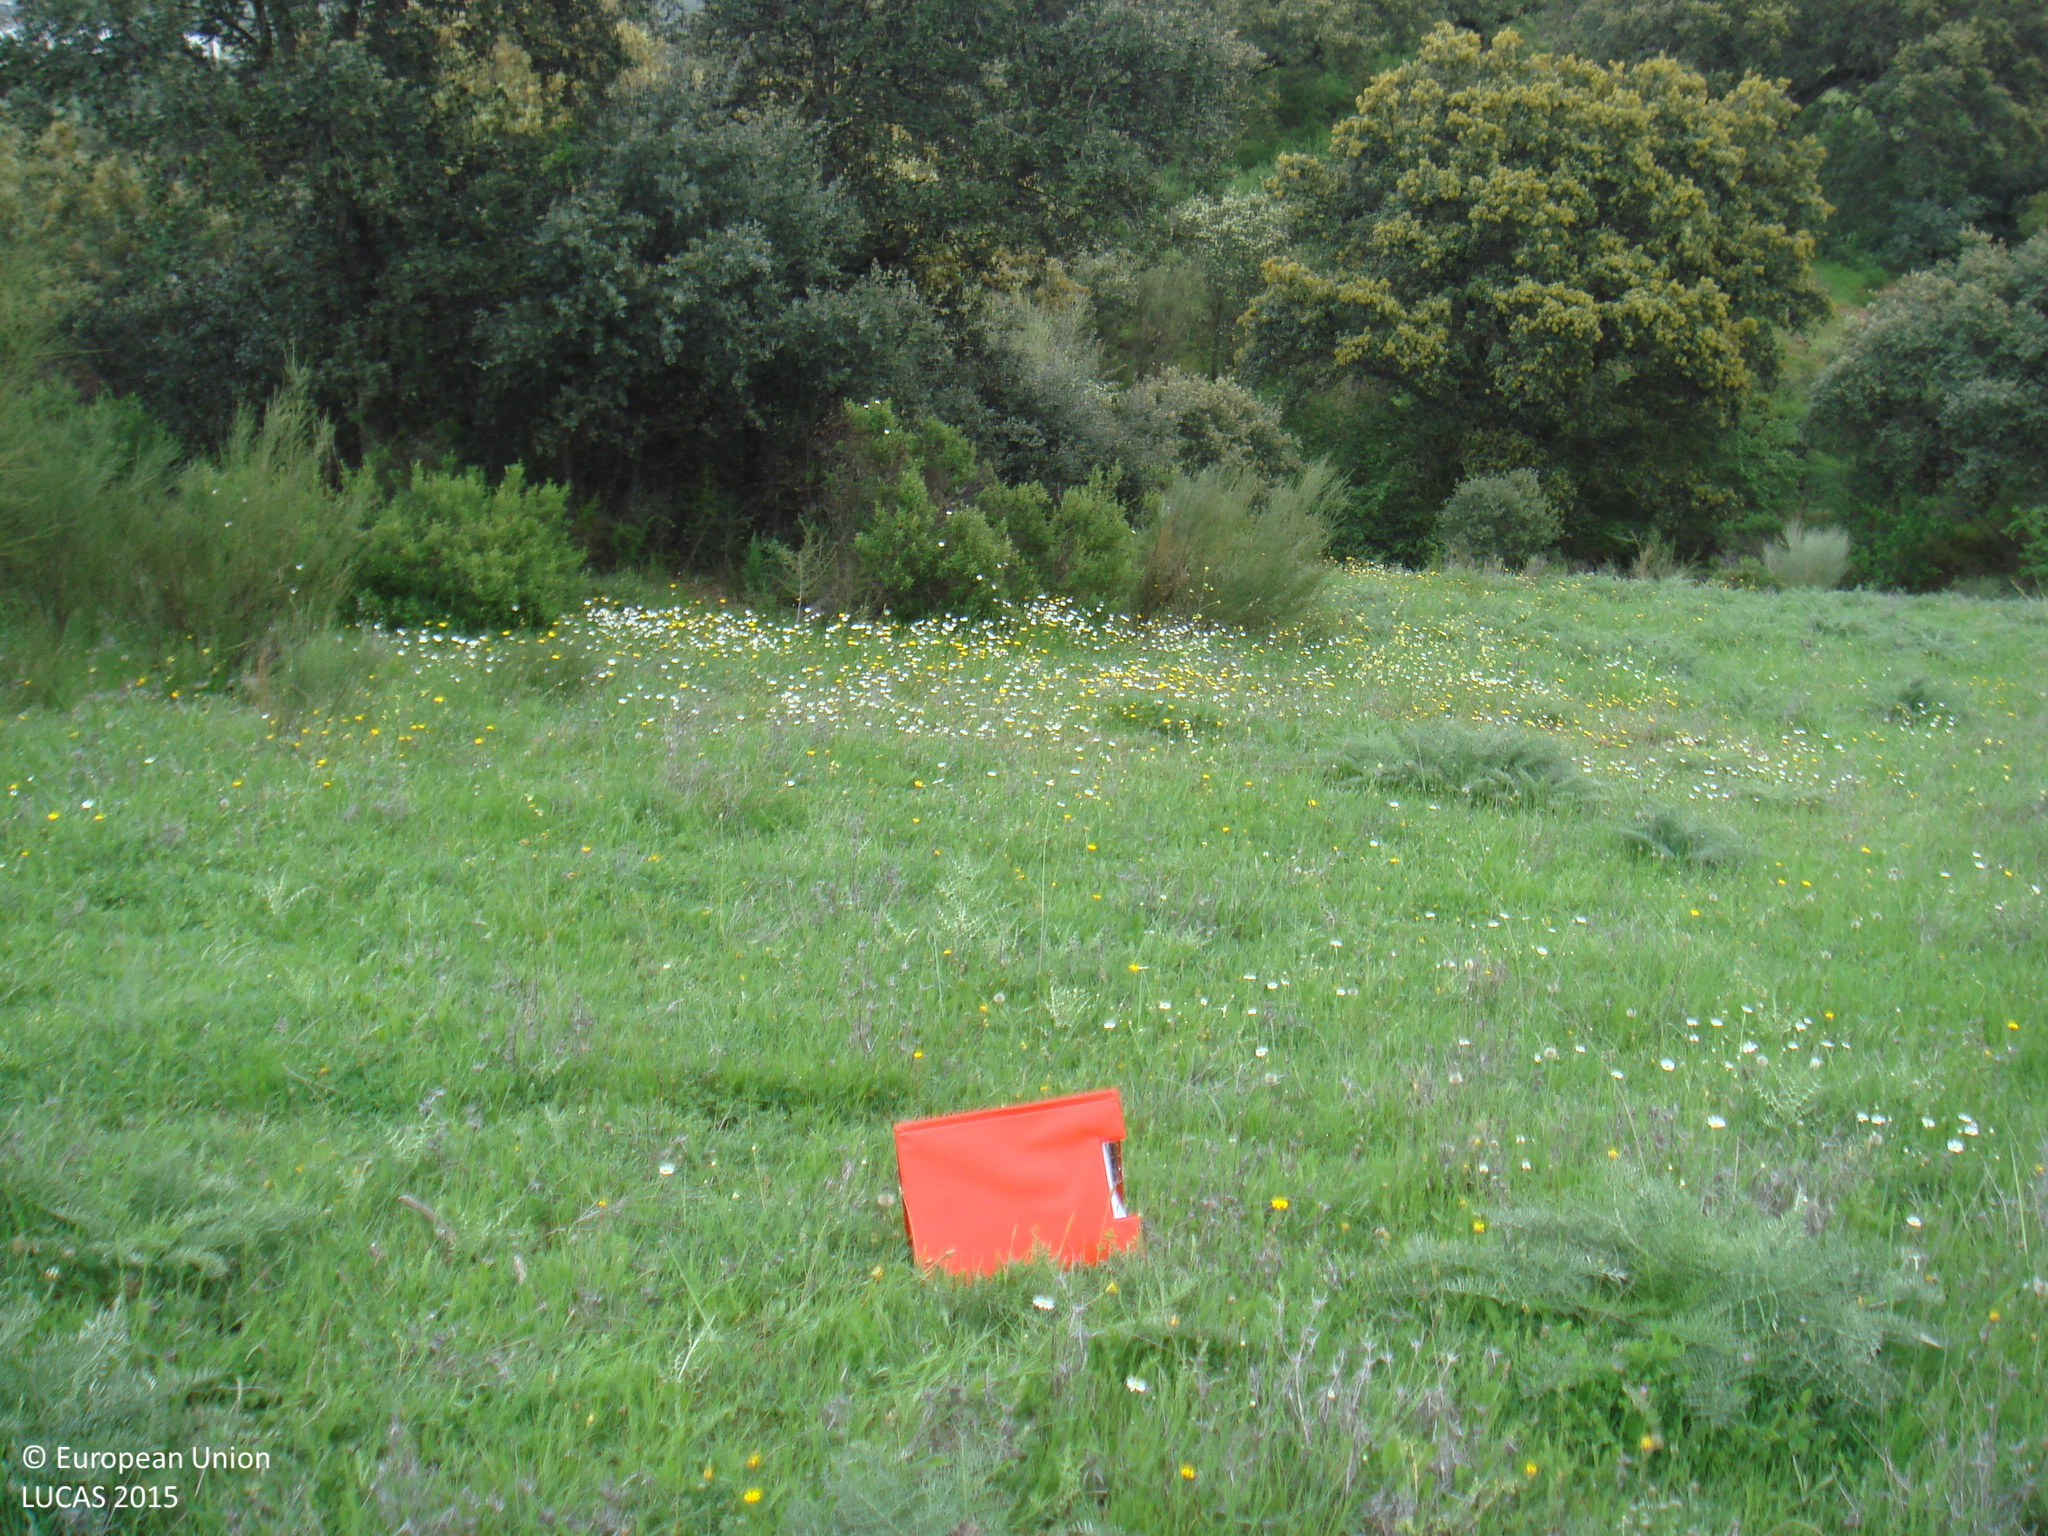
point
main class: Shrubland
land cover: Shrubland with sparse tree cover
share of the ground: > 75 %
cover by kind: shrubs 70 %, herbaceous plants 25 %, broadleaved forest trees 5 %
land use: Forestry
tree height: > 5 m
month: April
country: ES
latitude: 38.1823
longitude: -5.0354
